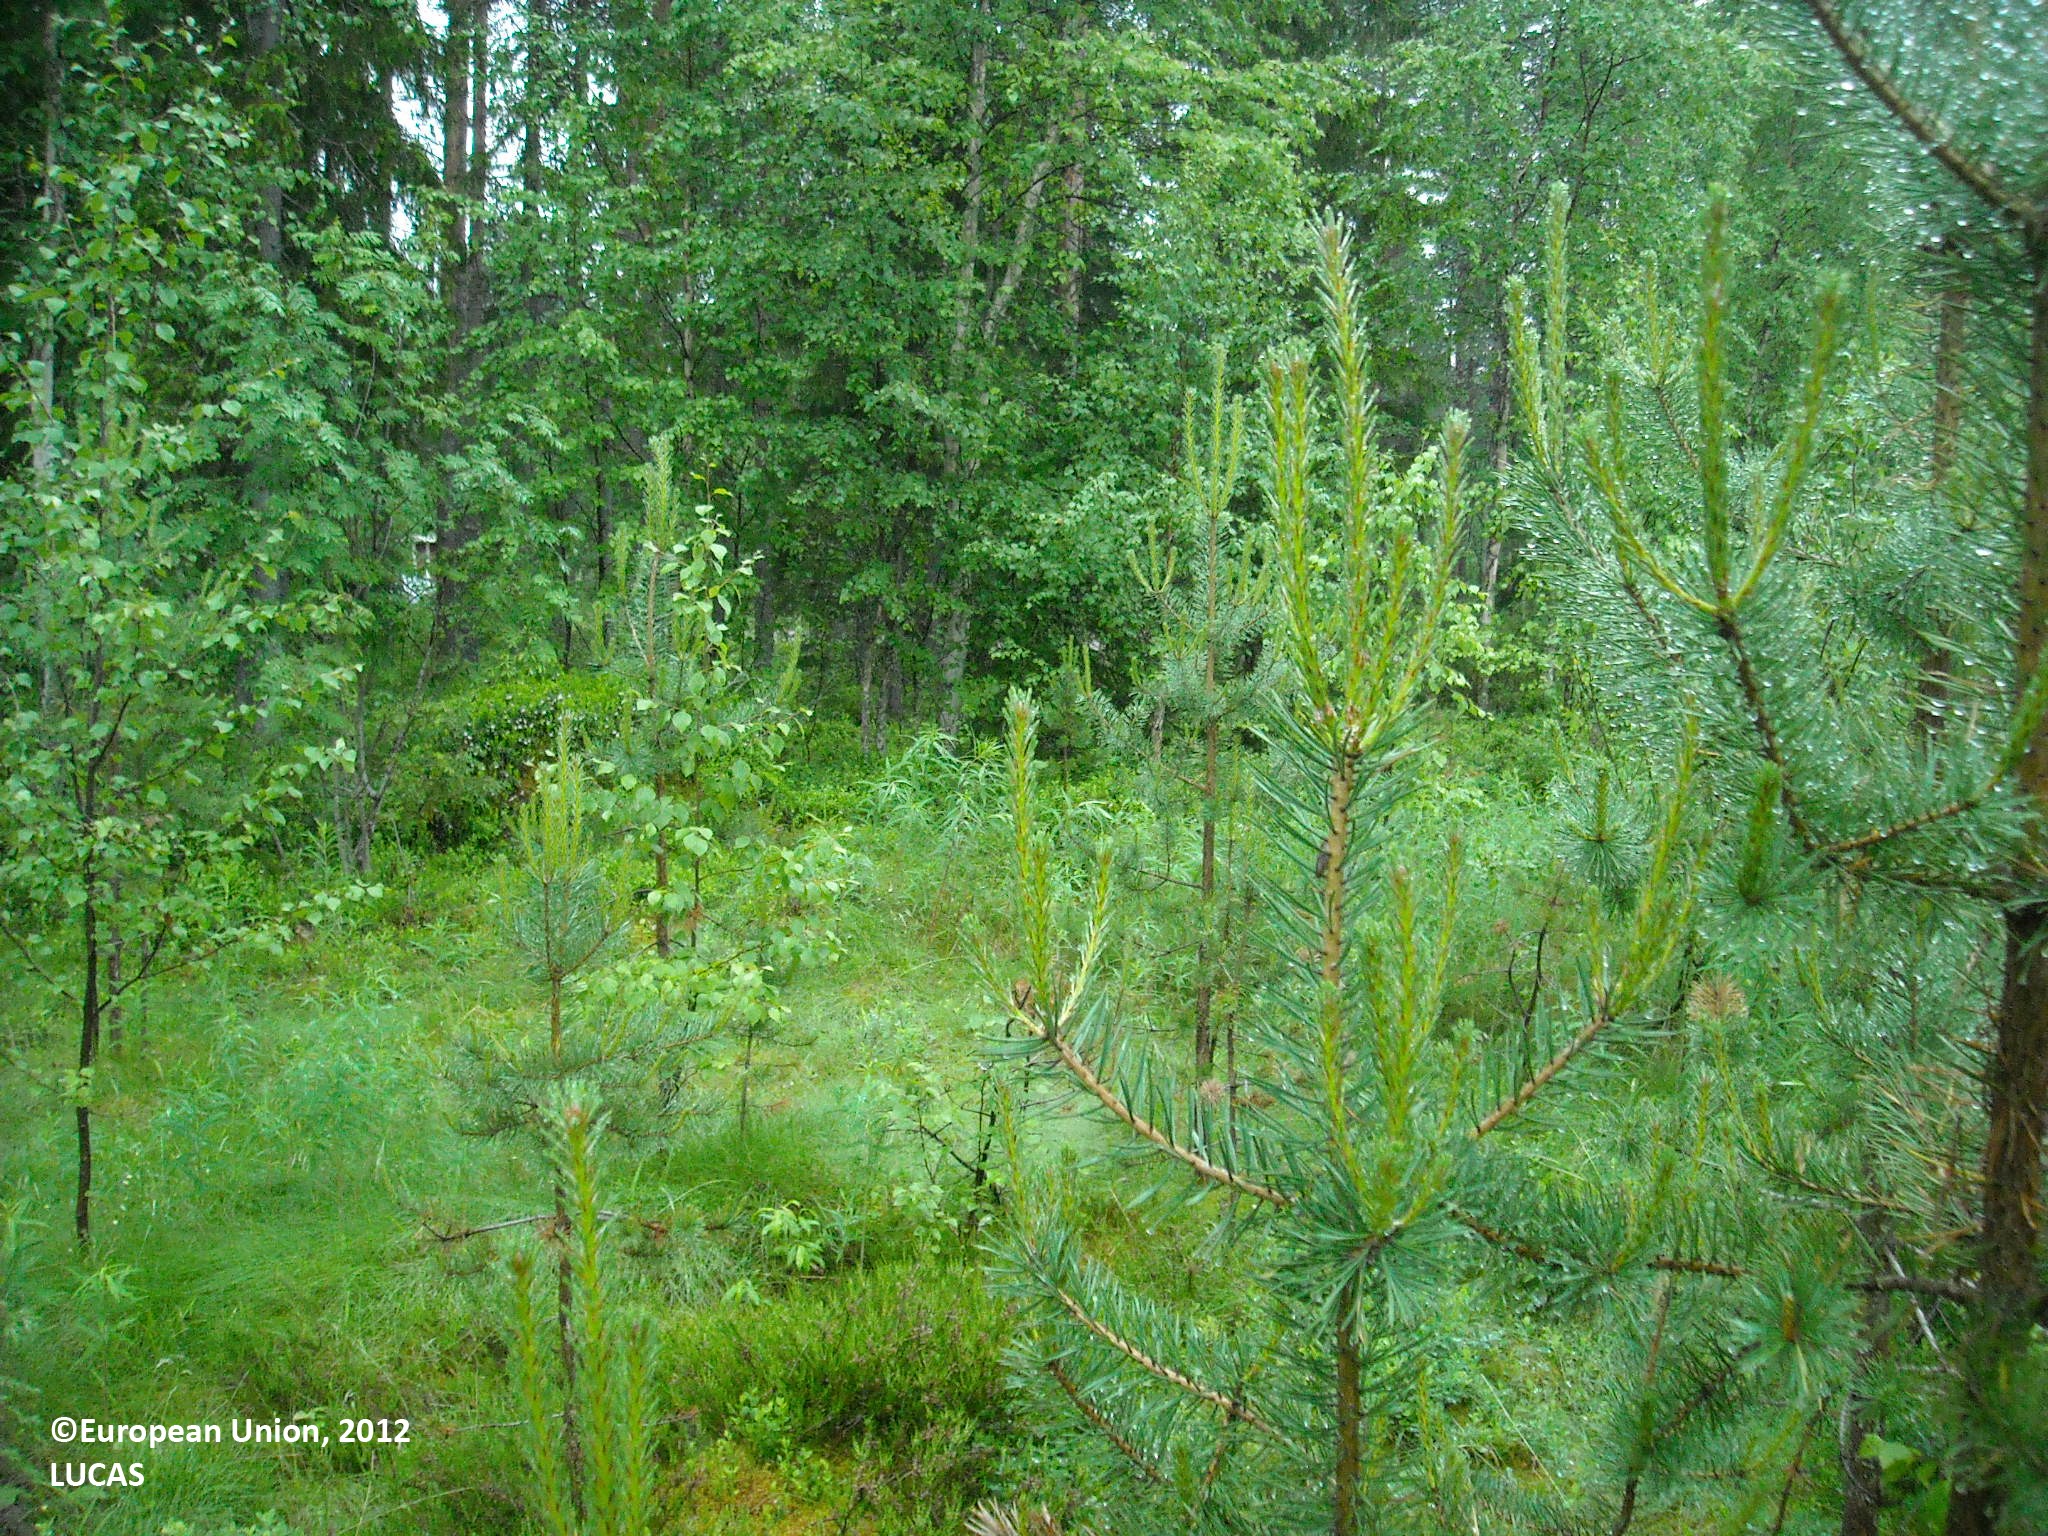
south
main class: Woodland
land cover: Pine dominated mixed woodland
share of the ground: > 75 %
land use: Forestry
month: July
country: FI
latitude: 64.5900
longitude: 27.6285
